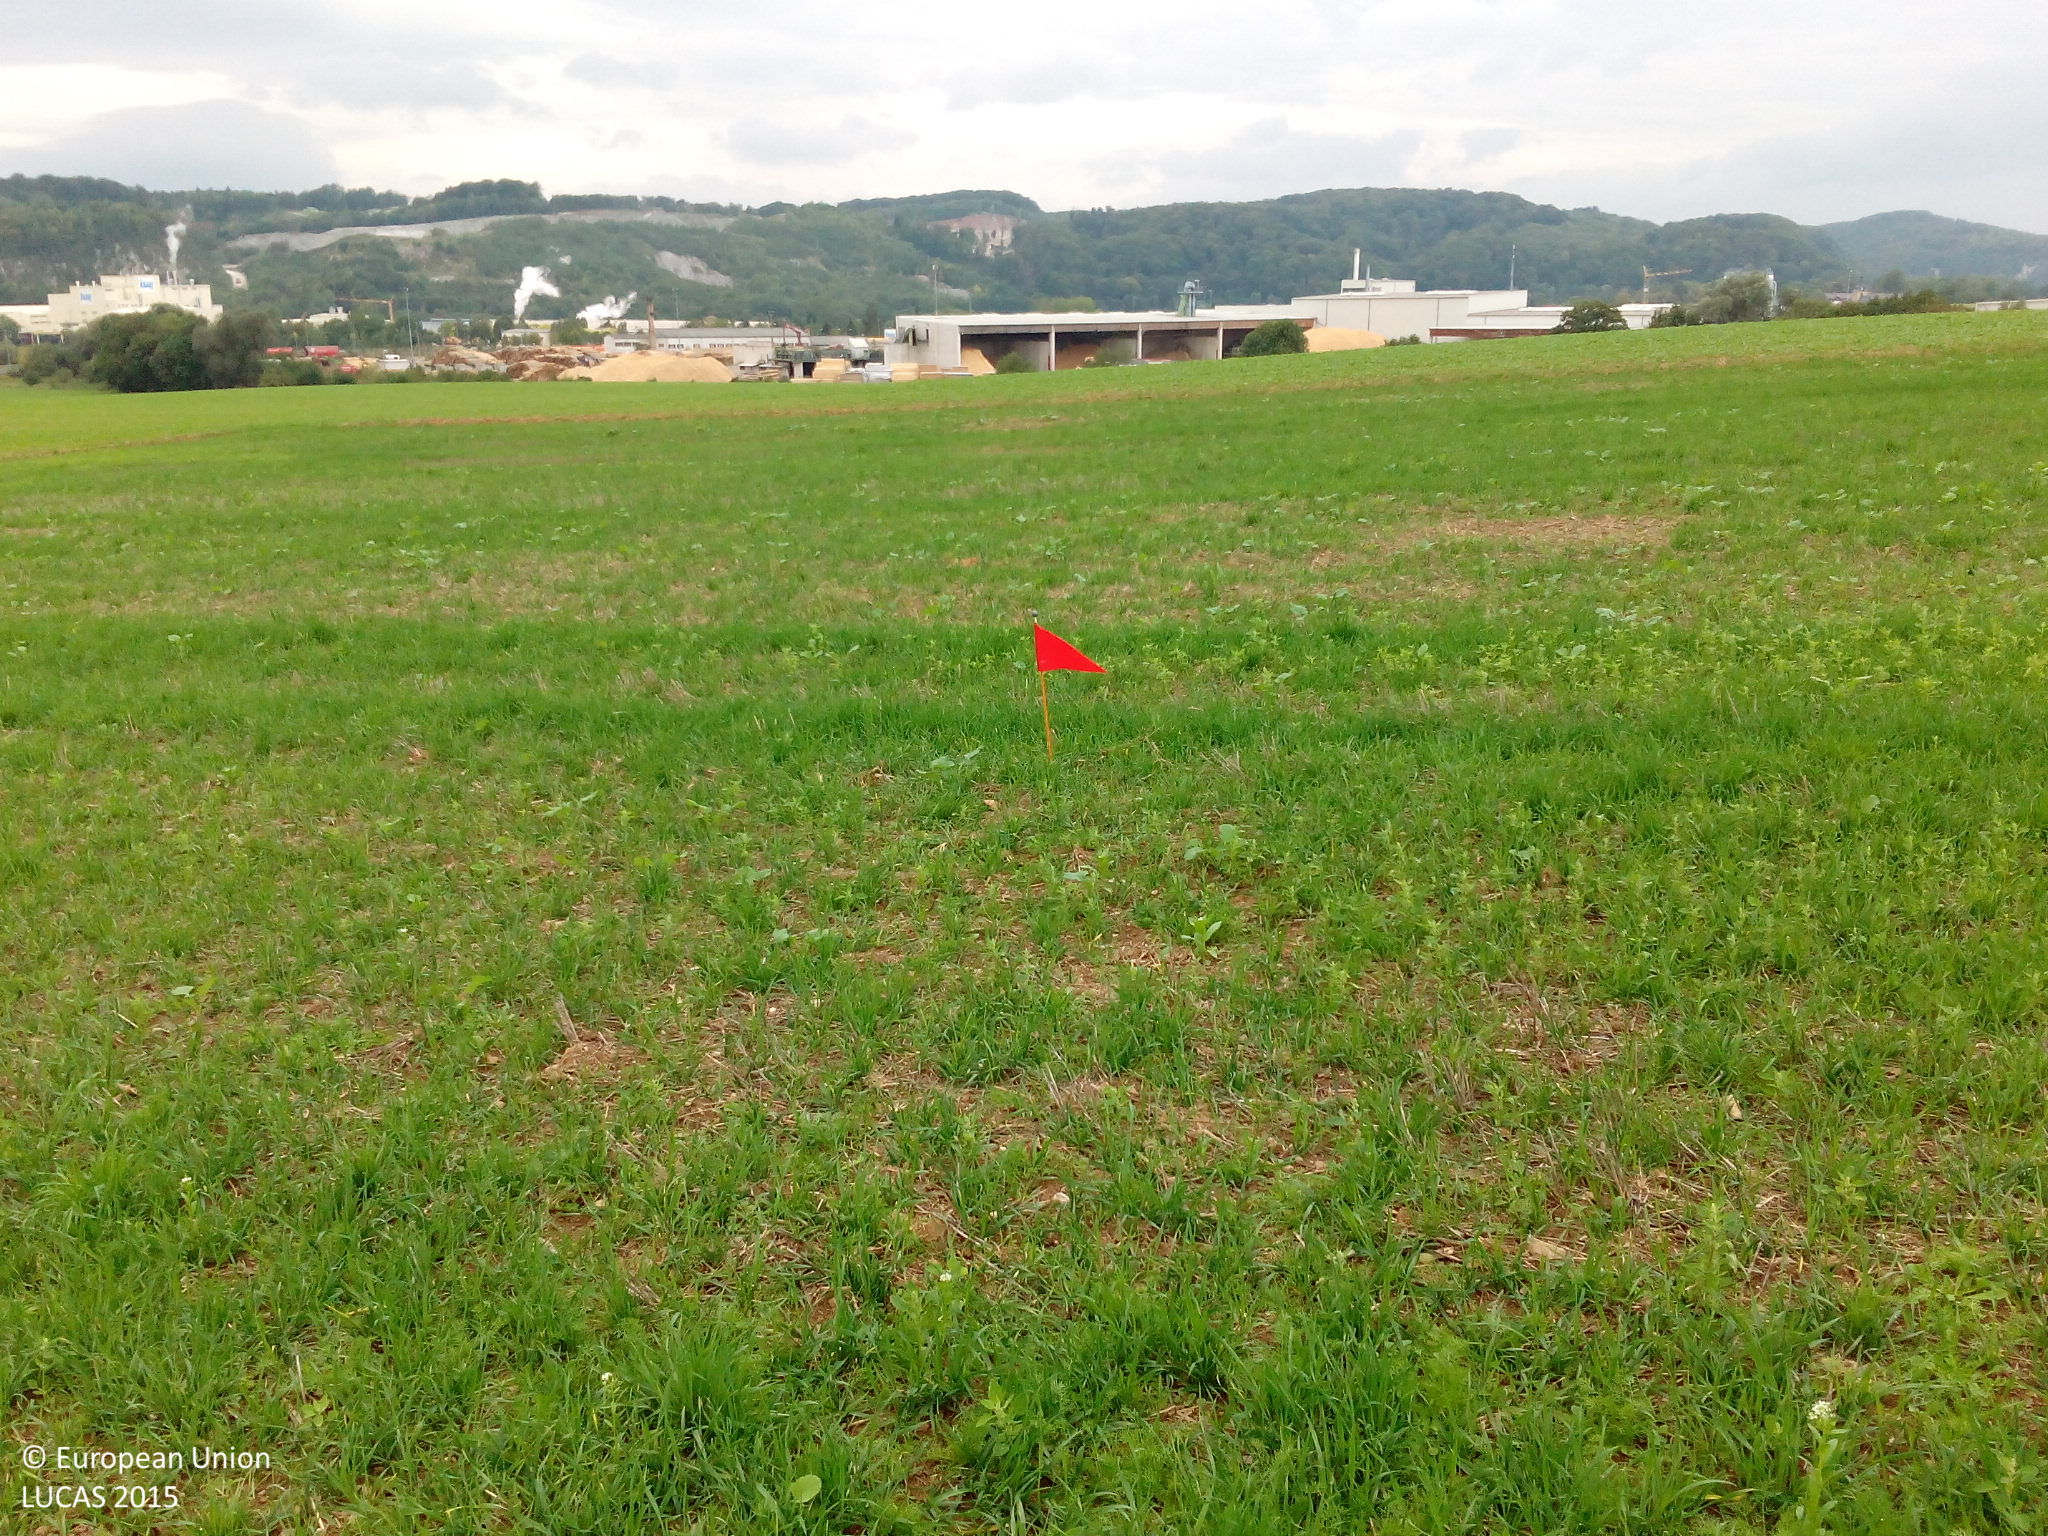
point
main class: Cropland
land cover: Common wheat
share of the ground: 50 - 75 %
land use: Agriculture (excluding fallow land and kitchen gardens)
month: September
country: DE
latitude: 51.5107
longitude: 10.9651
